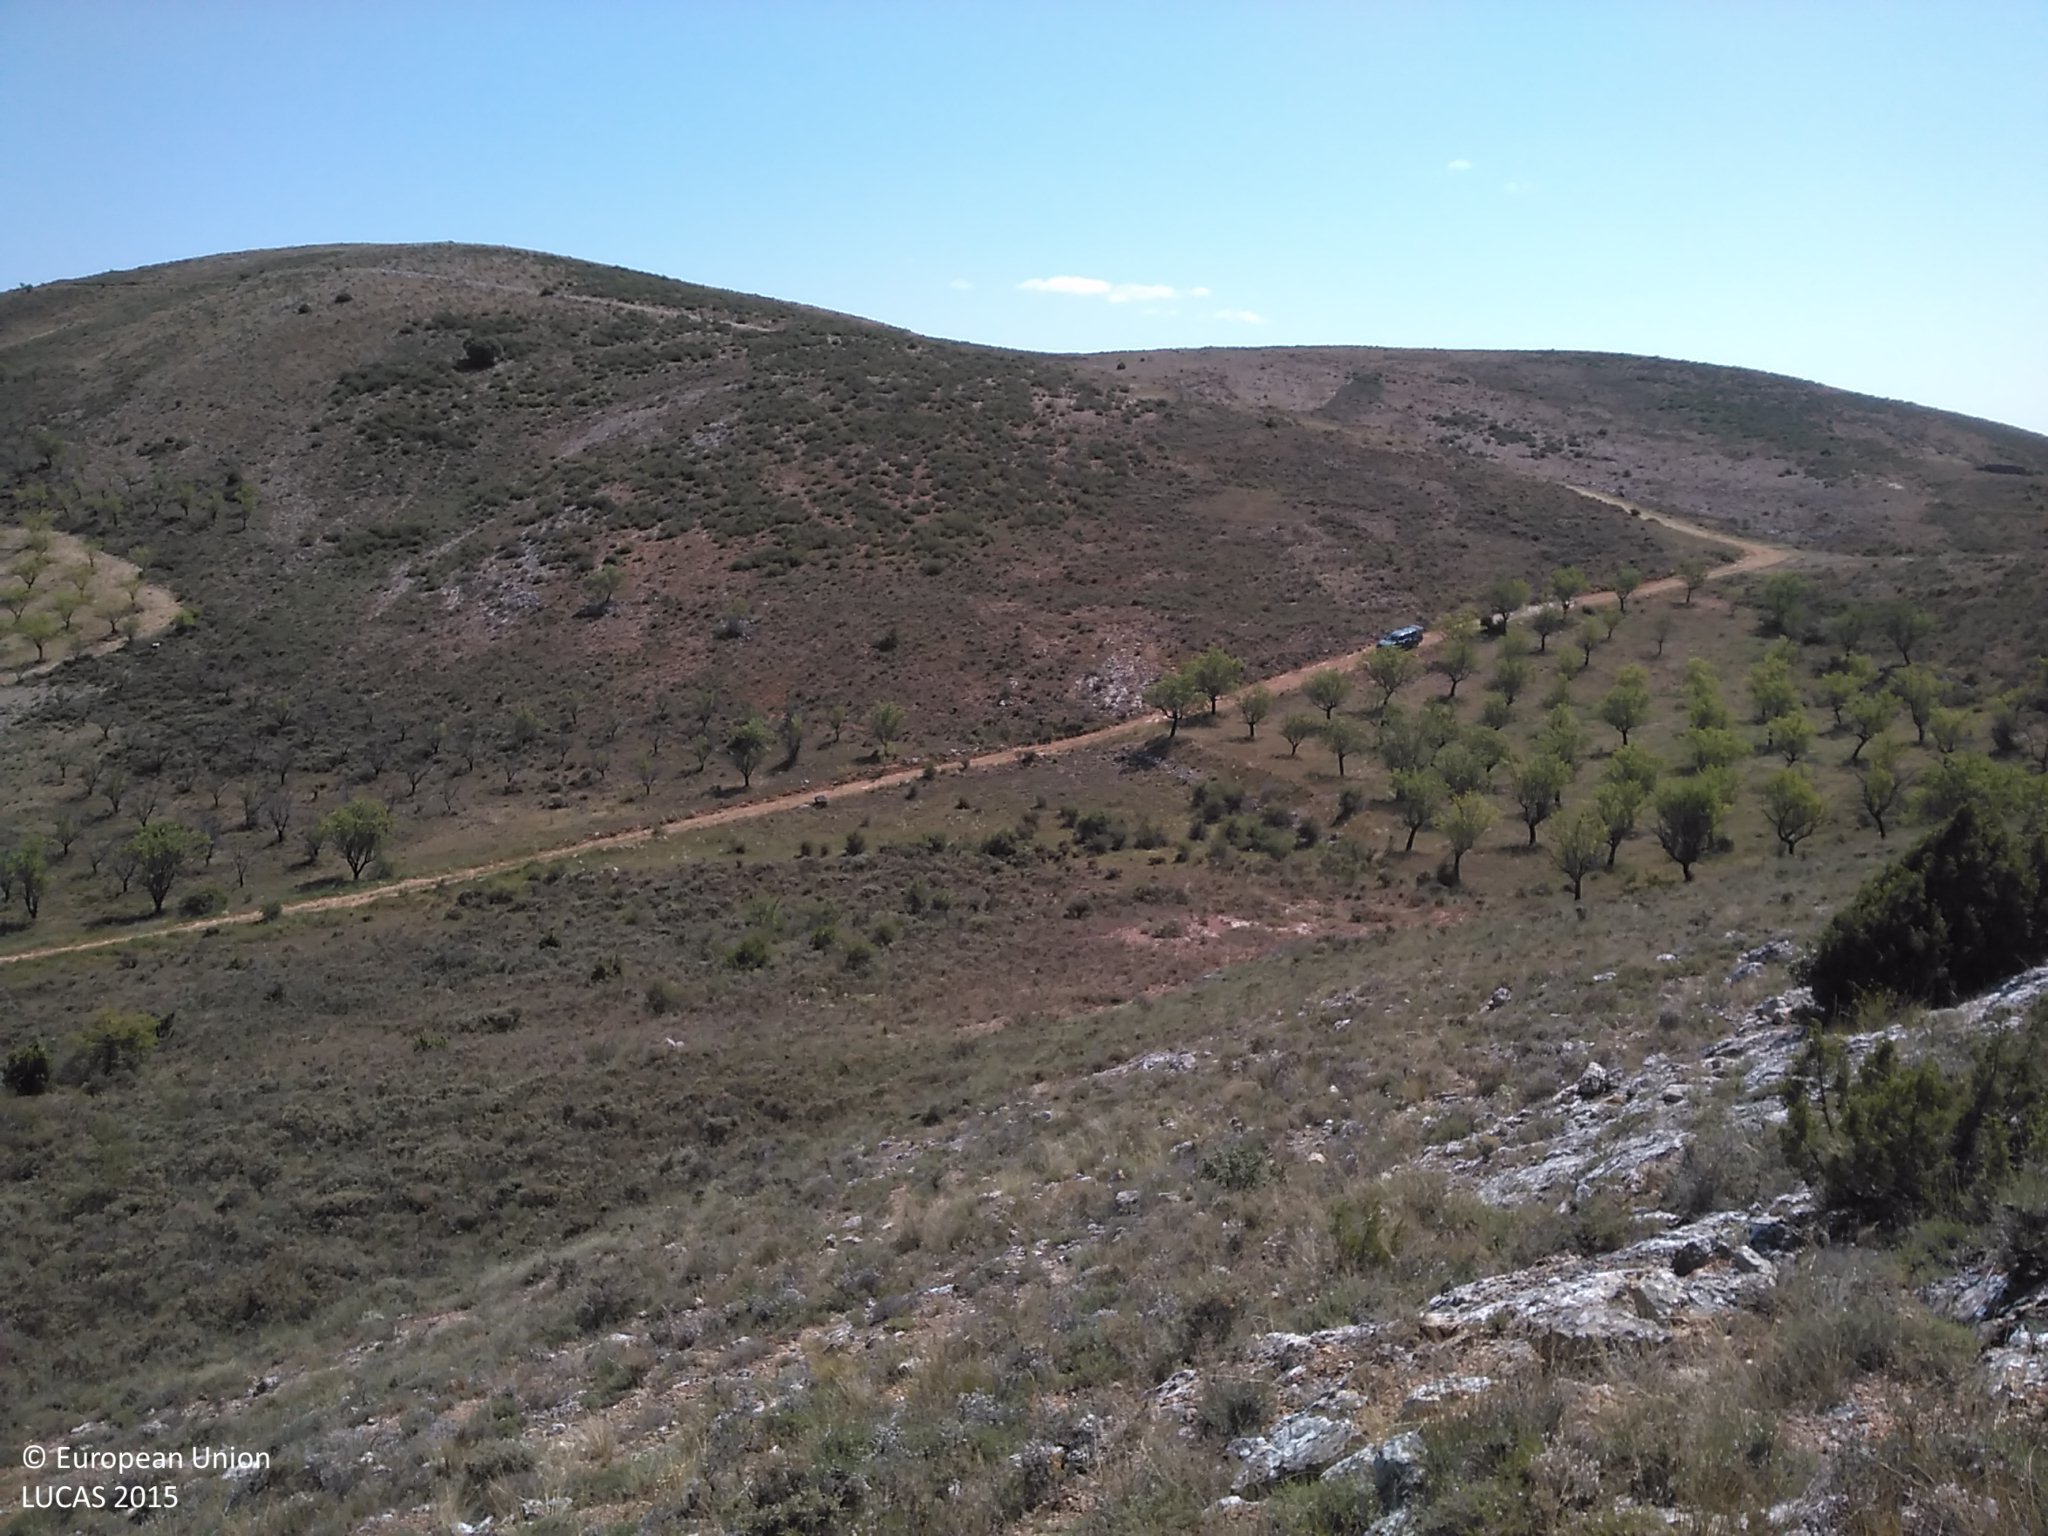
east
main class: Shrubland
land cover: Shrubland without tree cover
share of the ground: 25 - 50 %
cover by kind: shrubs 40 %, consolidated bare surface 25 %, unconsolidated bare surface 25 %, herbaceous plants 5 %, lichens and mosses 5 %
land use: Semi-natural and natural areas not in use
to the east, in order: Shrubland without tree cover; Nuts trees; Tracks; Shrubland without tree cover
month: July
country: ES
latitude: 41.5117
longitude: -1.9031
